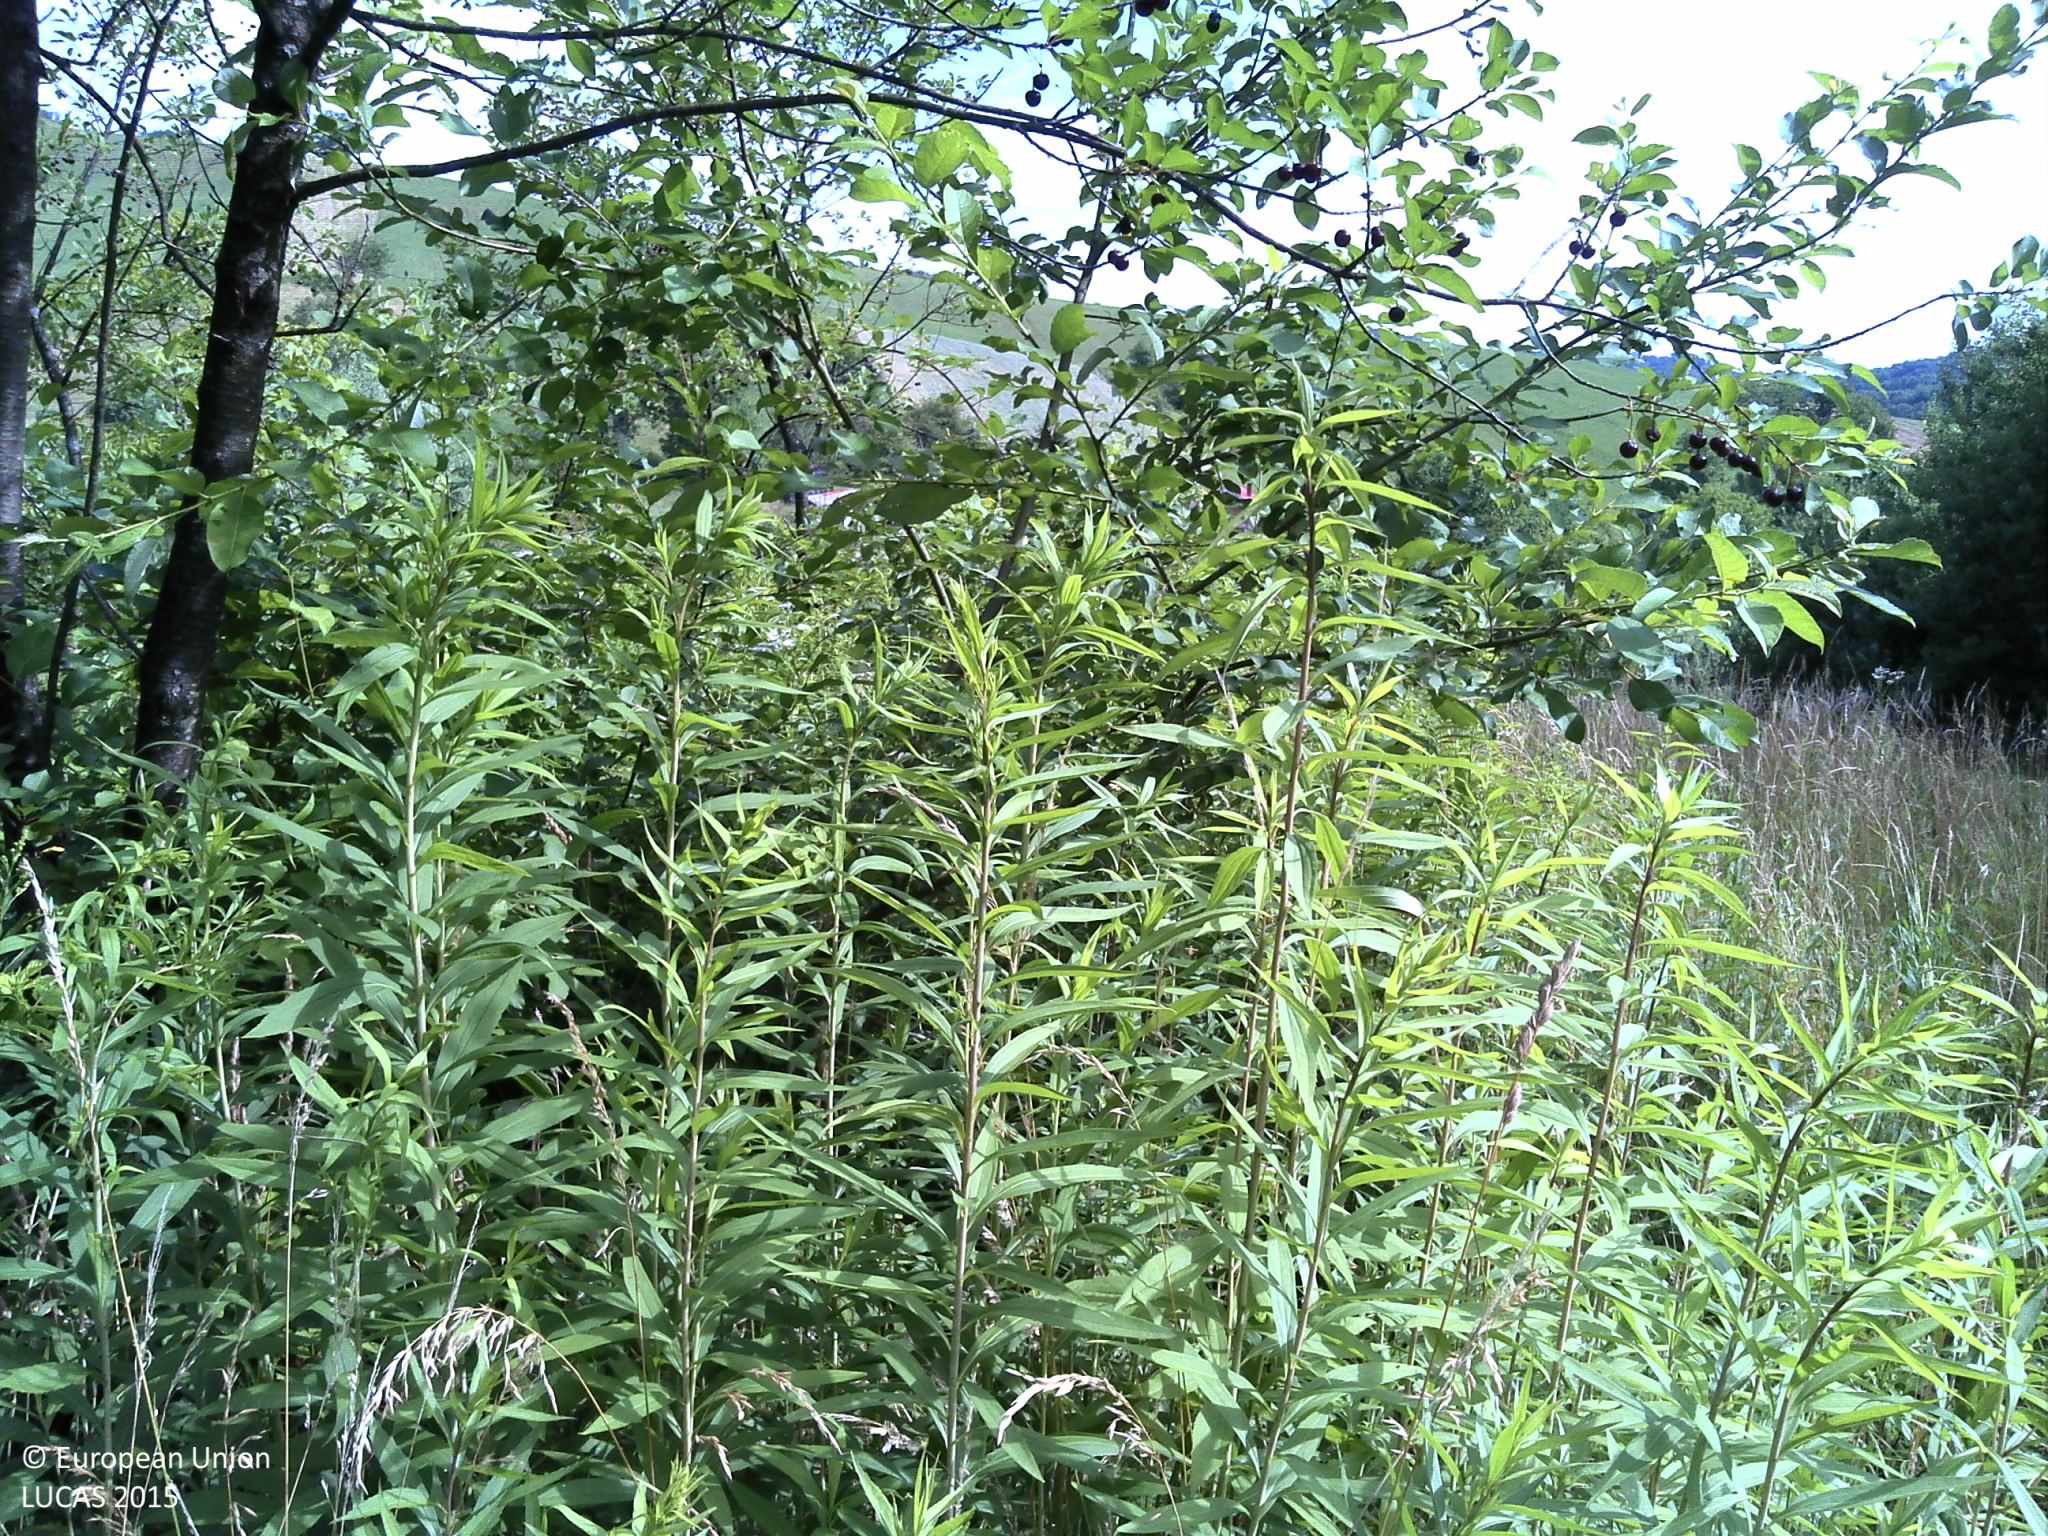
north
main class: Grassland
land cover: Spontaneously vegetated surfaces
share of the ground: > 75 %
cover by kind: herbaceous plants 100 %
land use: Fallow land
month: June
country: HR
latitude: 45.7873
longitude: 17.3985
